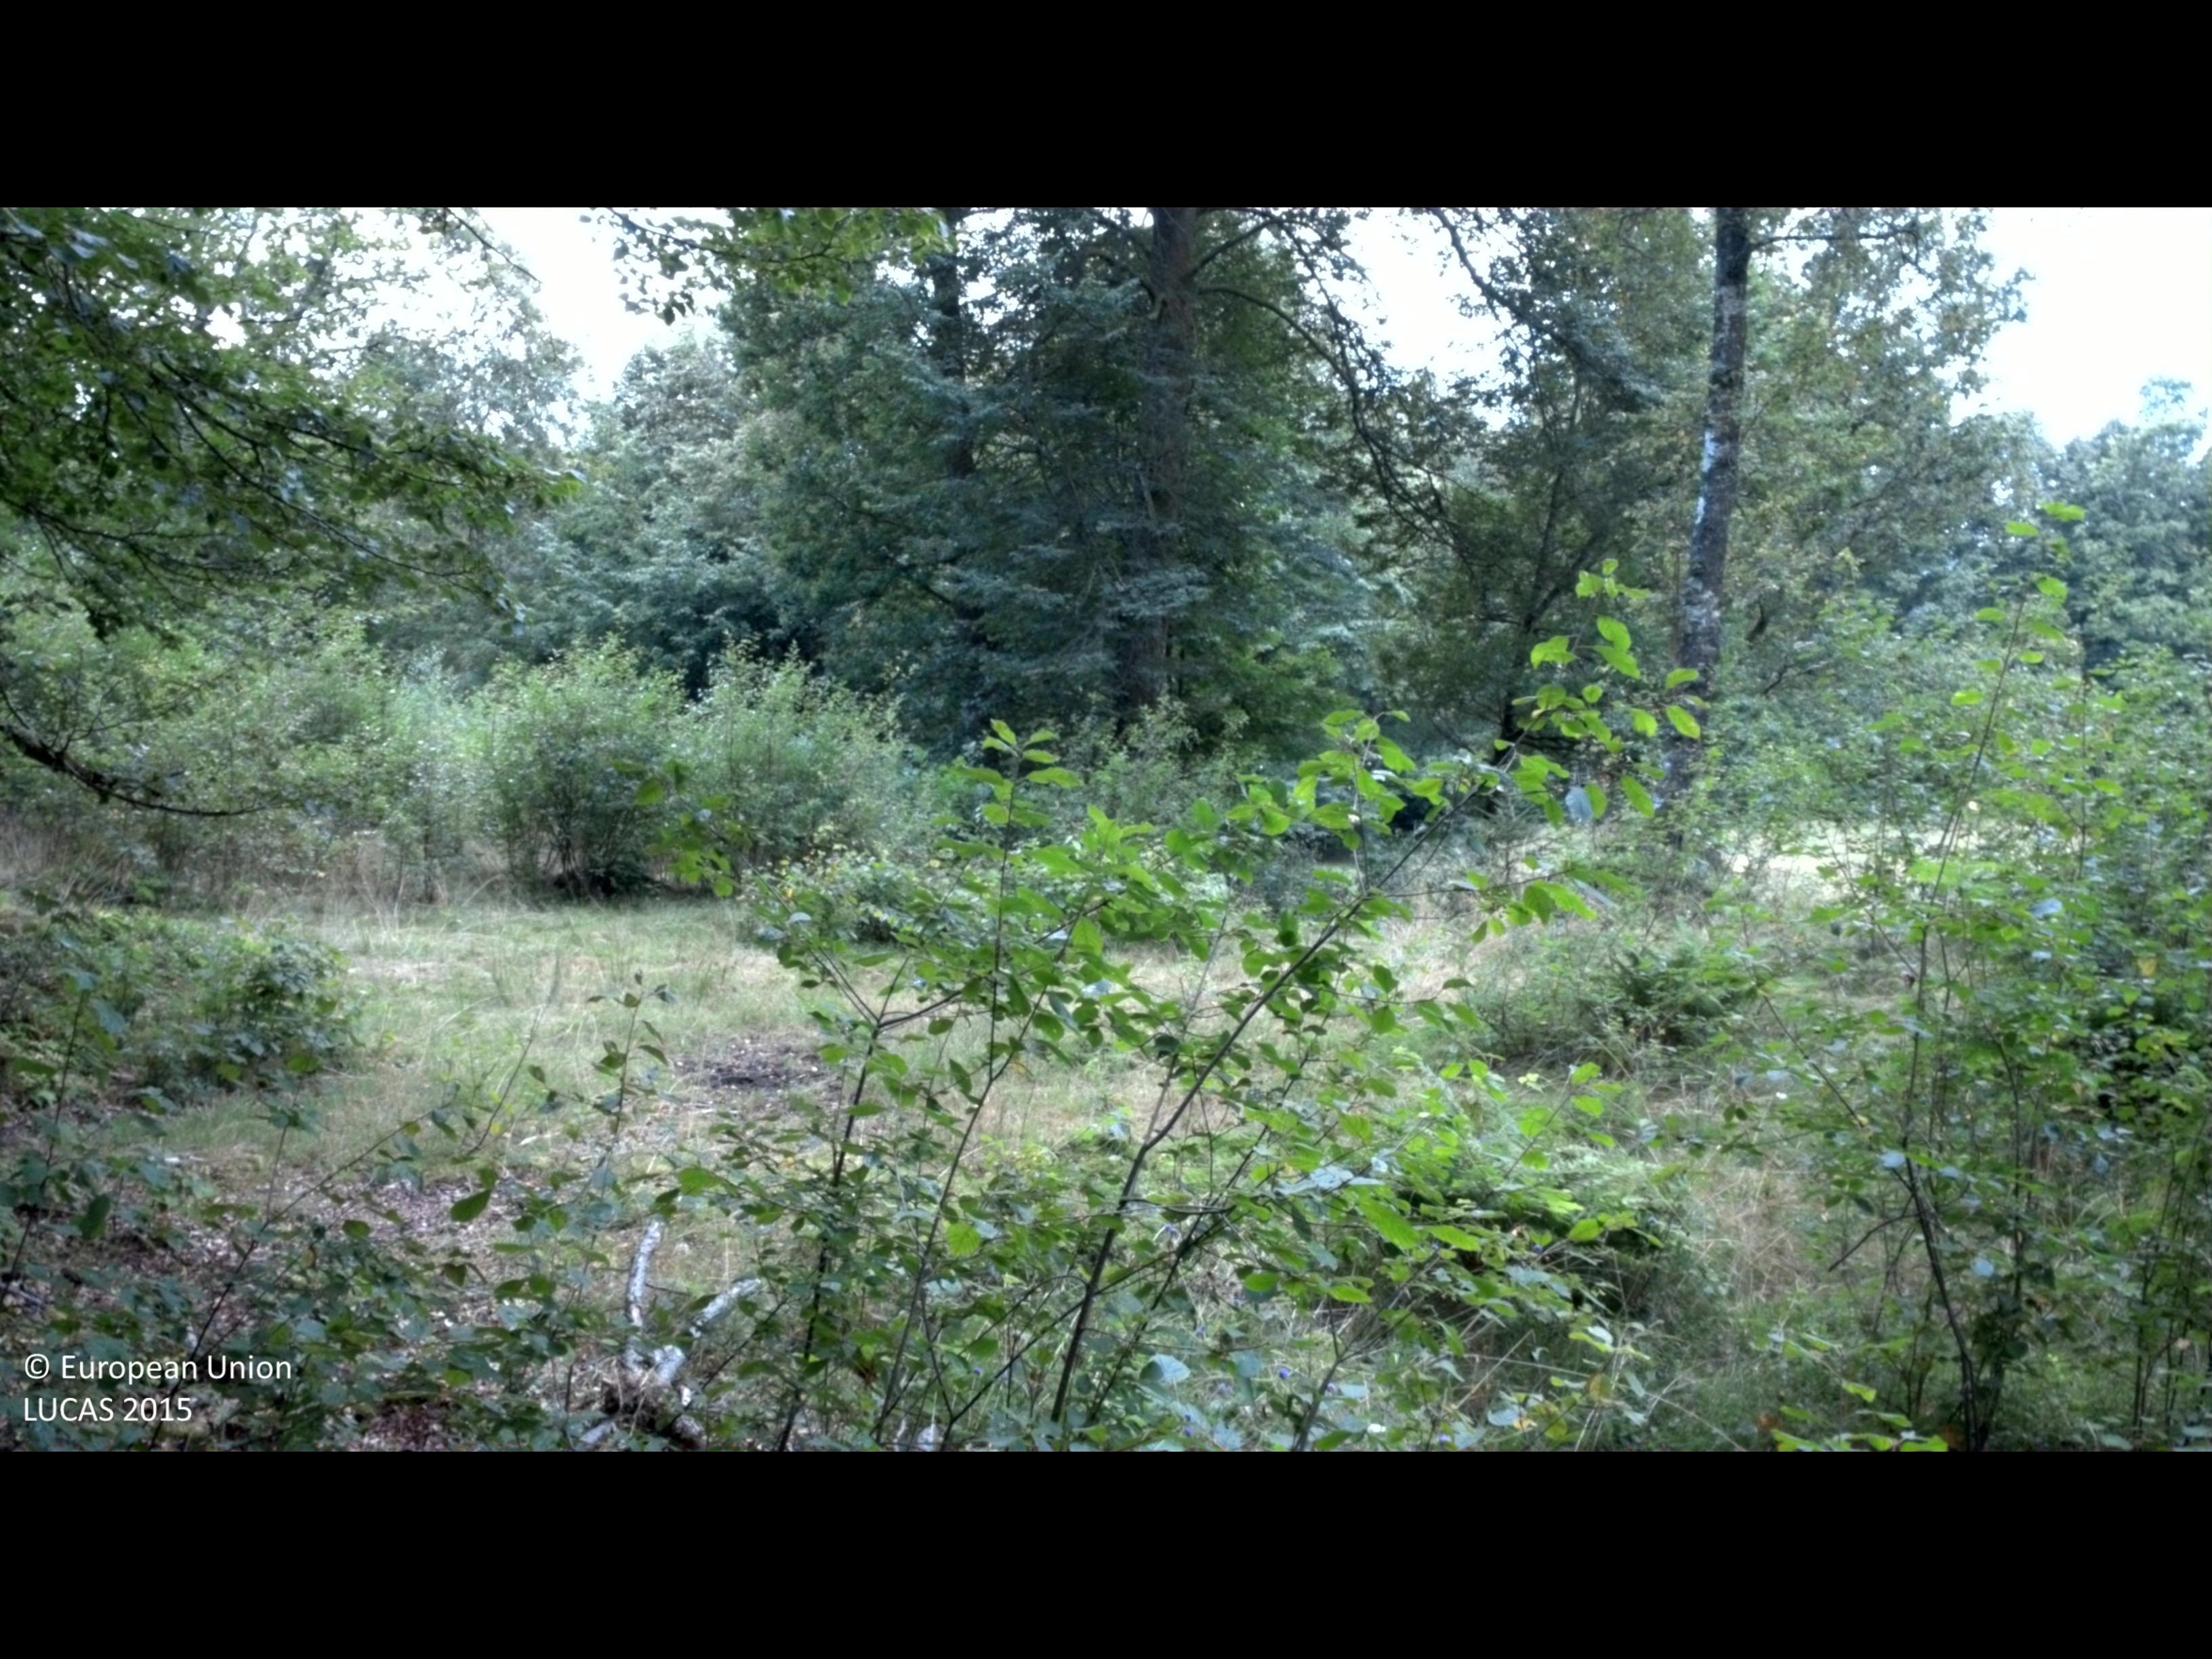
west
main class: Woodland
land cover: Broadleaved woodland
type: hemiboreal forest and nemoral coniferous forest and mixed broadleaved-coniferous forest
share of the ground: 50 - 75 %
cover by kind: broadleaved forest trees 70 %, herbaceous plants 30 %
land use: Agriculture (excluding fallow land and kitchen gardens)
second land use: Forestry
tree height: > 5 m
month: August
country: SE
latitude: 56.7600
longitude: 13.1864
